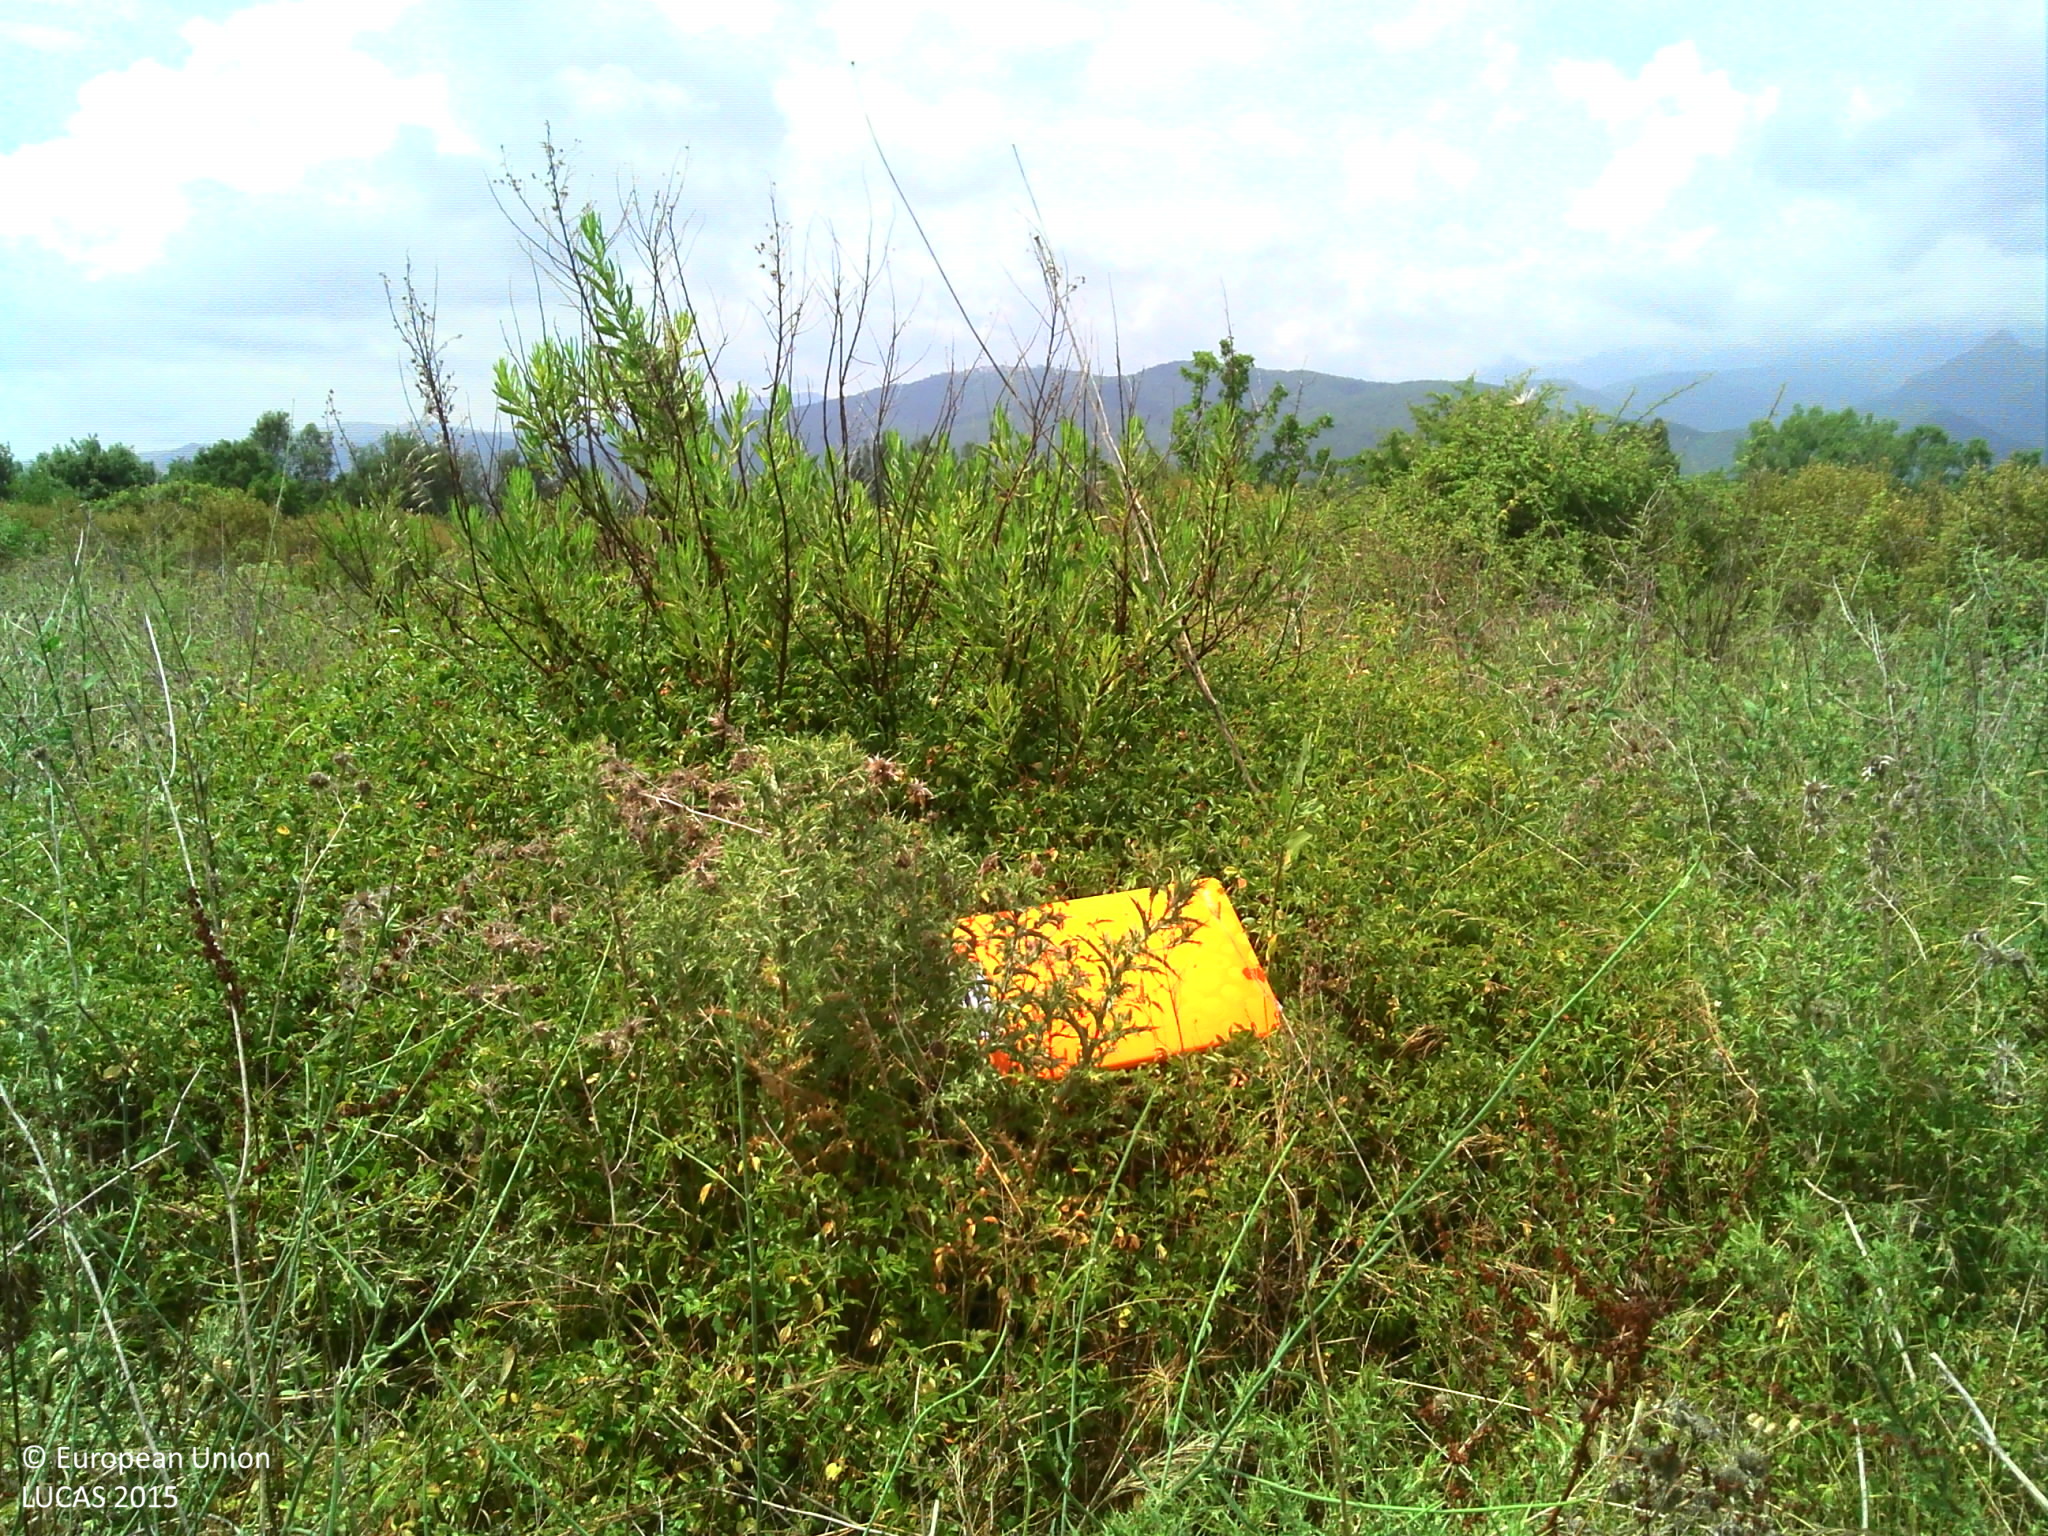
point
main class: Shrubland
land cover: Shrubland without tree cover
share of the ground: > 75 %
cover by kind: shrubs 85 %, herbaceous plants 15 %
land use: Agriculture (excluding fallow land and kitchen gardens)
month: July
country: FR
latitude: 42.0558
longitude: 9.3620
